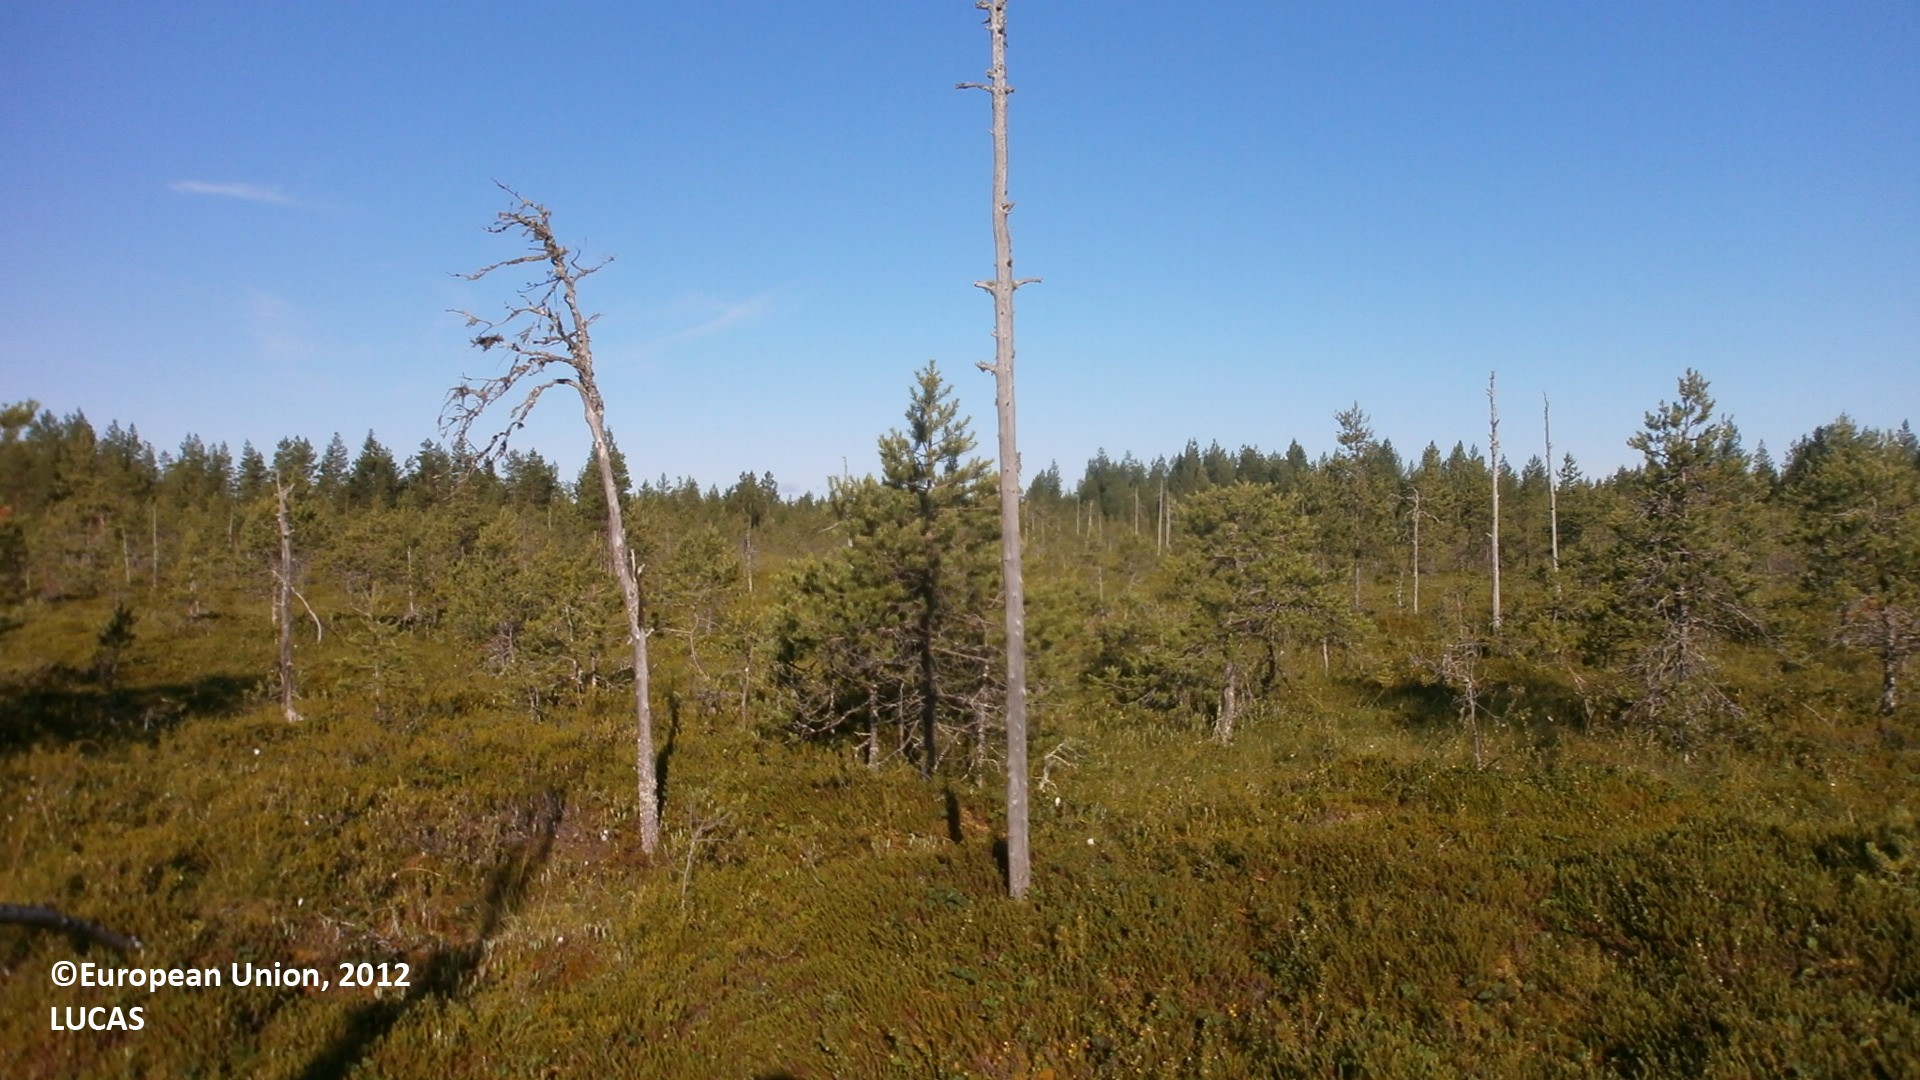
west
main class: Woodland
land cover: Pine dominated coniferous woodland
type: boreal forest
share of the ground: 10 - 25 %
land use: Semi-natural and natural areas not in use
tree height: < 5 m
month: July
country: FI
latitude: 64.0200
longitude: 24.1237
